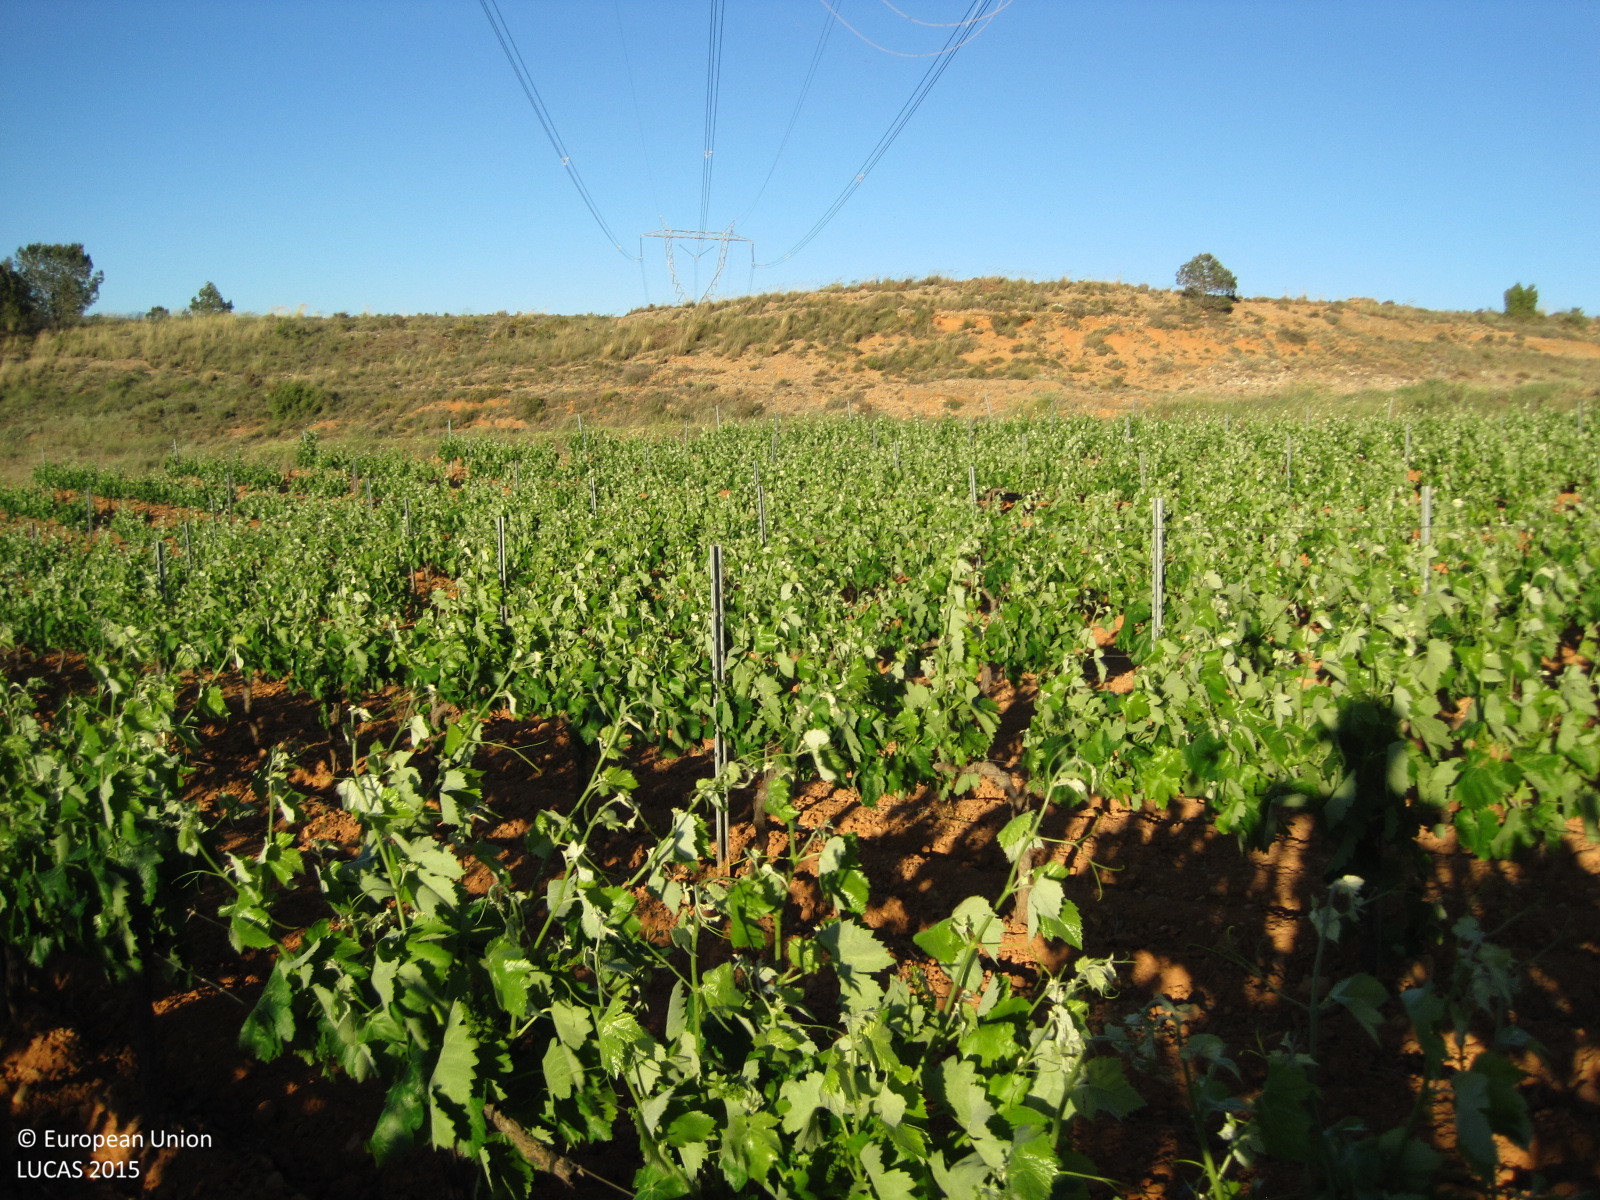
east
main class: Artificial land
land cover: Other artificial areas
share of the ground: > 75 %
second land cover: Vineyards
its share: 25 - 50 %
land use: Electricity, gas and thermal power distribution
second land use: Agriculture (excluding fallow land and kitchen gardens)
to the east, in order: Electric lines; Vineyards; Other bare soil; Tracks; Grassland with sparse tree/shrub cover; Grassland without tree/shrub cover; Tracks; Grassland without tree/shrub cover
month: May
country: ES
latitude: 39.4709
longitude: -1.1021
